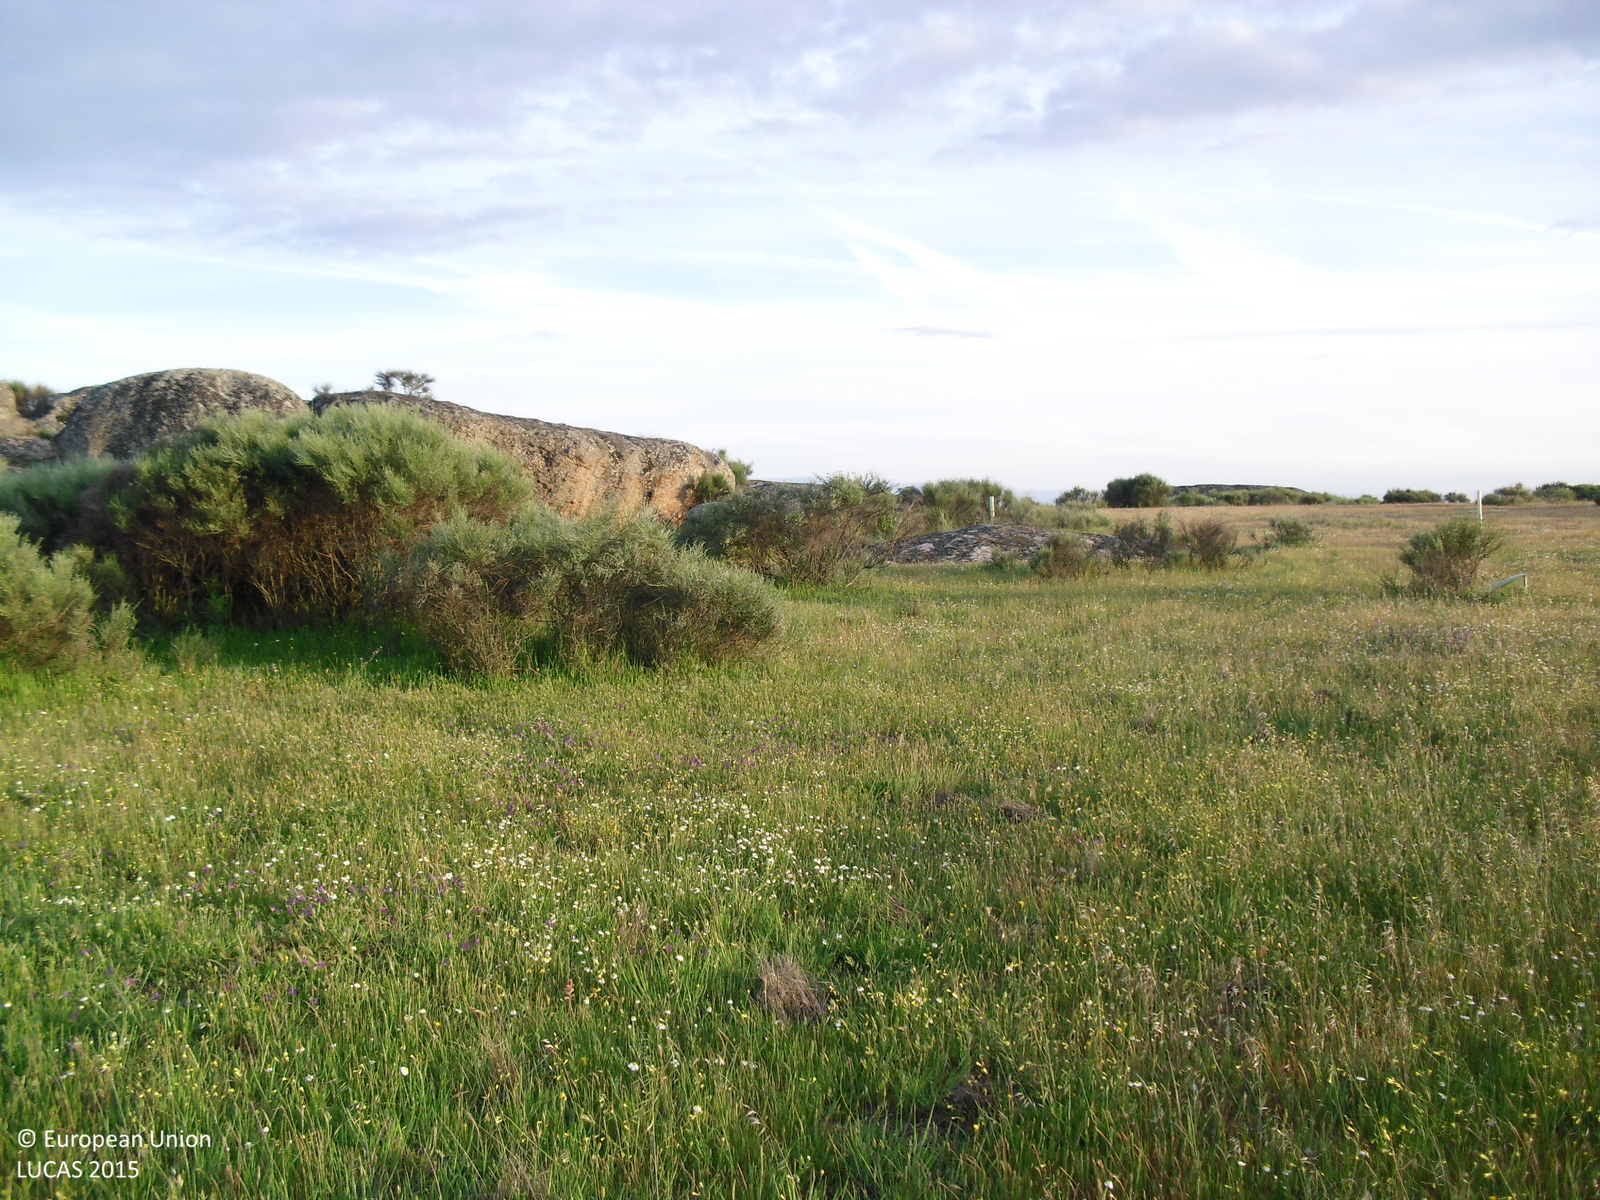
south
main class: Grassland
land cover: Grassland without tree/shrub cover
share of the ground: > 75 %
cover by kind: herbaceous plants 100 %
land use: Agriculture (excluding fallow land and kitchen gardens)
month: April
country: ES
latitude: 39.5153
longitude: -6.4354
